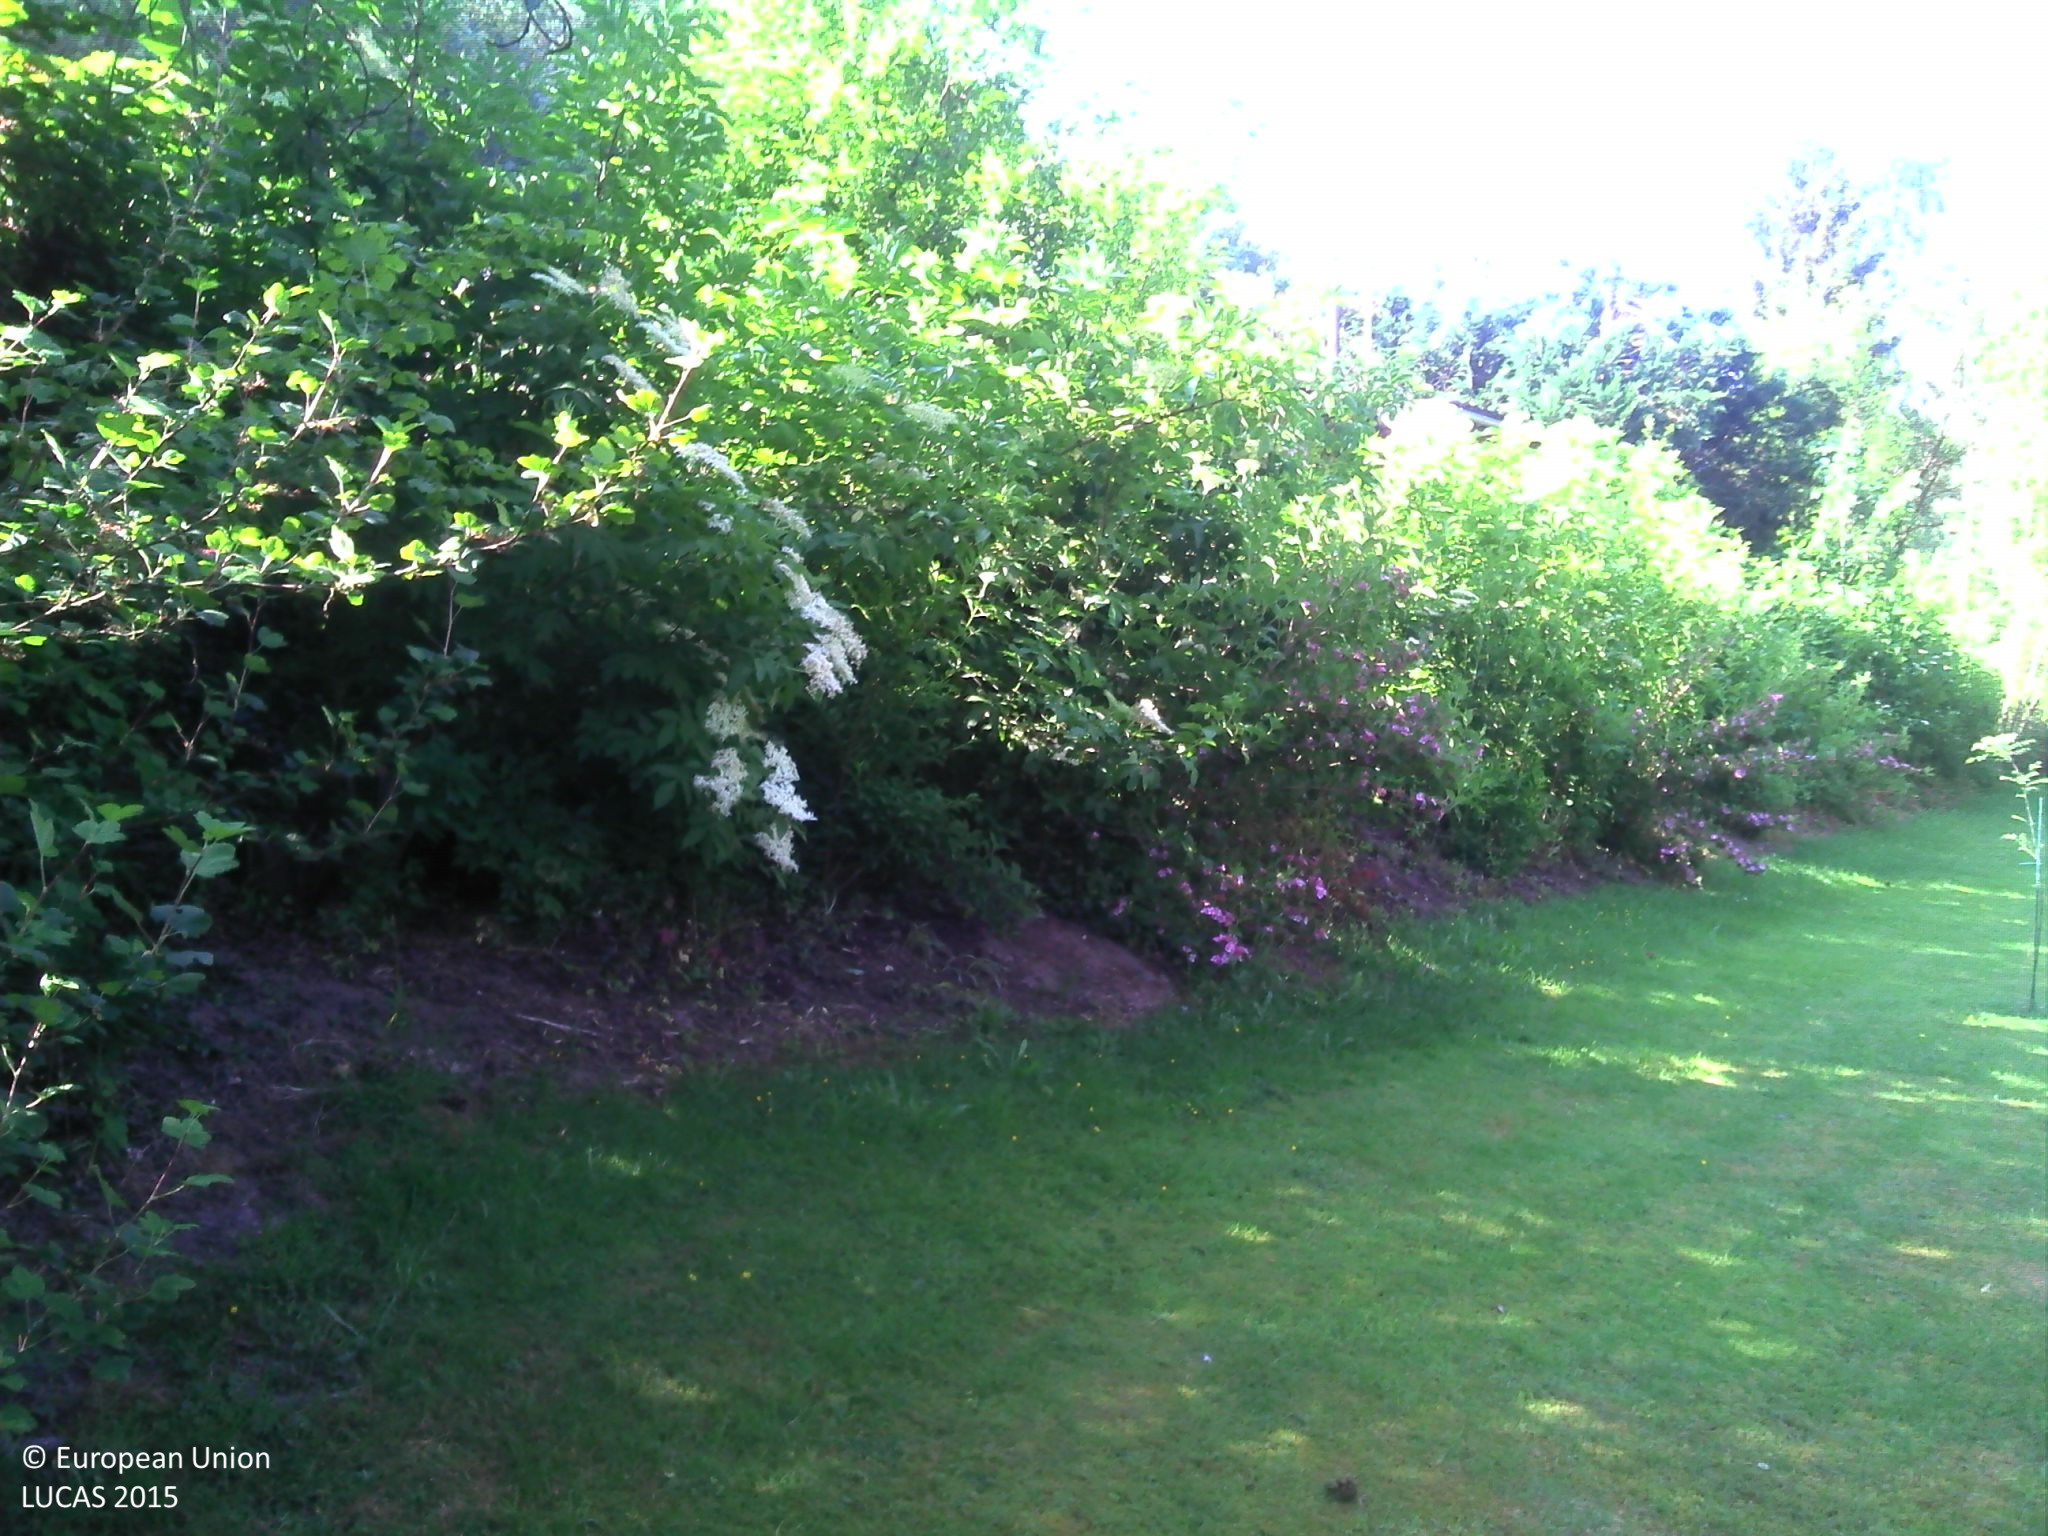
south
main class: Woodland
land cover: Broadleaved woodland
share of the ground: 50 - 75 %
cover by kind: broadleaved forest trees 60 %, herbaceous plants 25 %, coniferous forest trees 15 %
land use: Residential
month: June
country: BE
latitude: 50.0532
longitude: 4.5351
